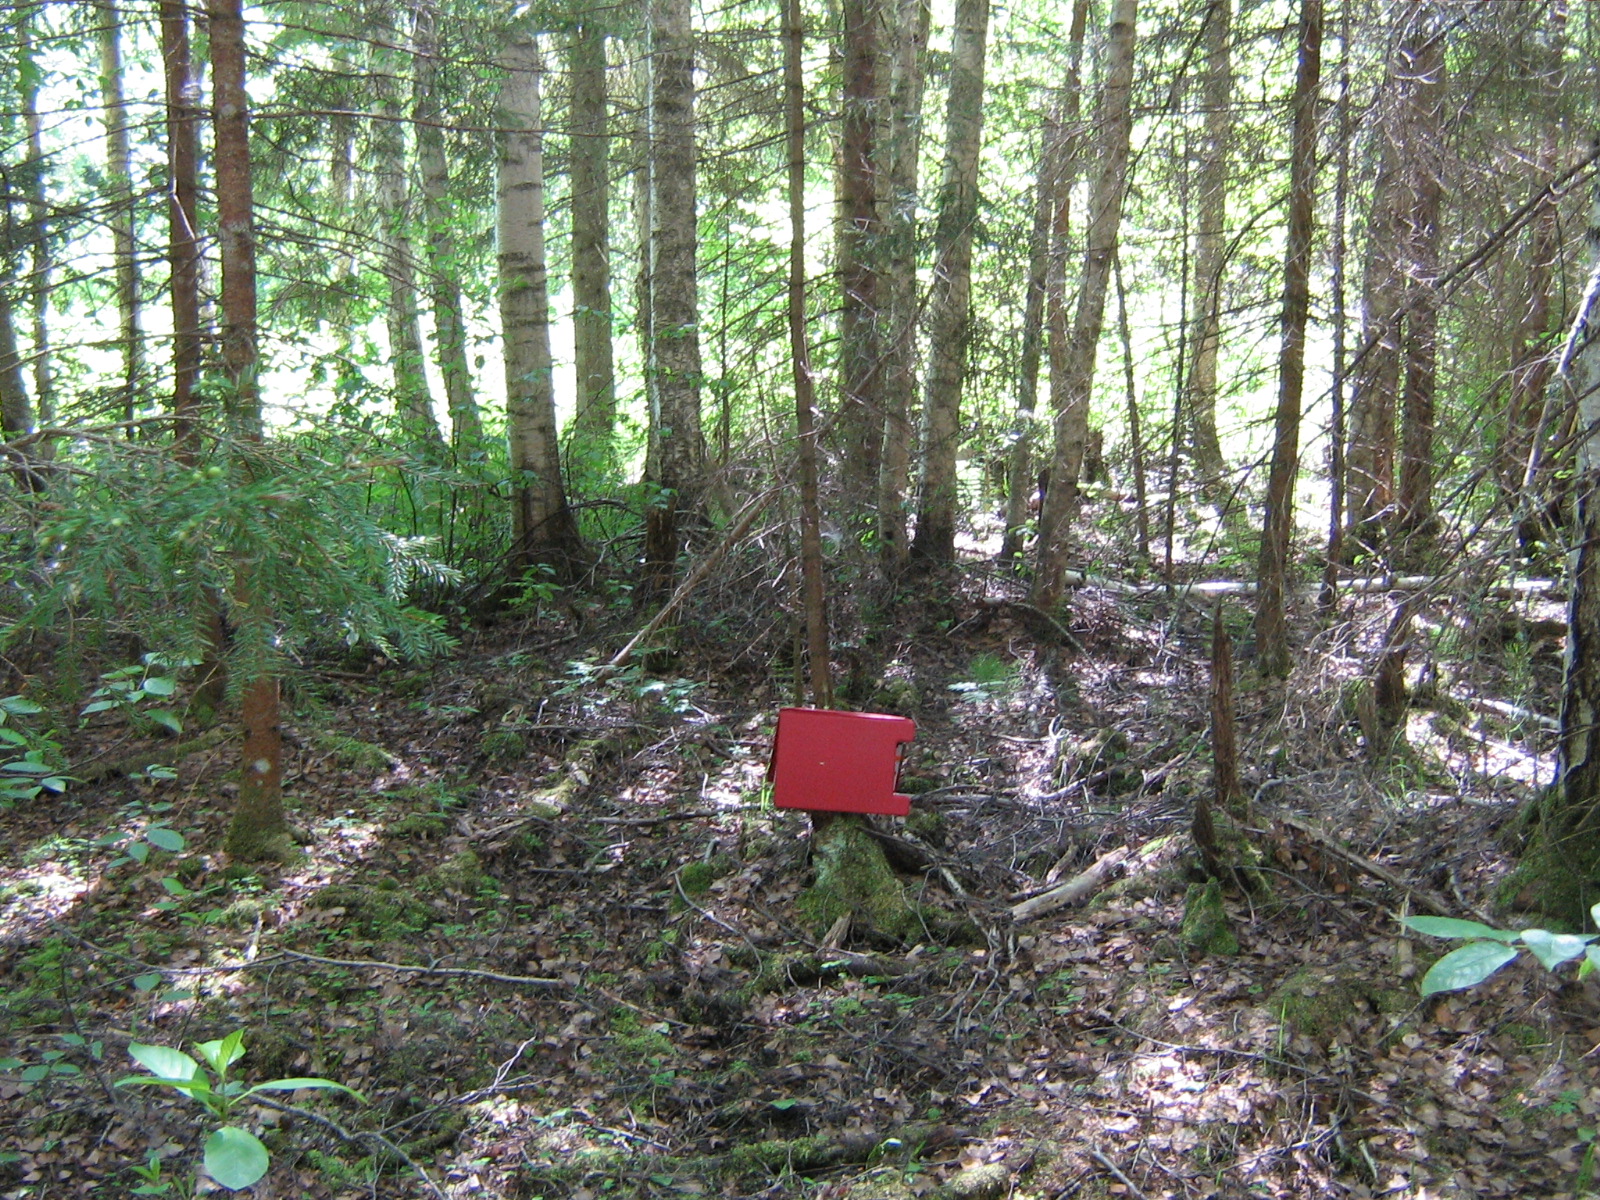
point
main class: Woodland
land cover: Other mixed woodland
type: hemiboreal forest and nemoral coniferous forest and mixed broadleaved-coniferous forest
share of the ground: > 75 %
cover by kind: broadleaved forest trees 65 %, coniferous forest trees 35 %
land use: Forestry
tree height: > 5 m
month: June
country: LV
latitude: 57.0856
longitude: 25.8517
